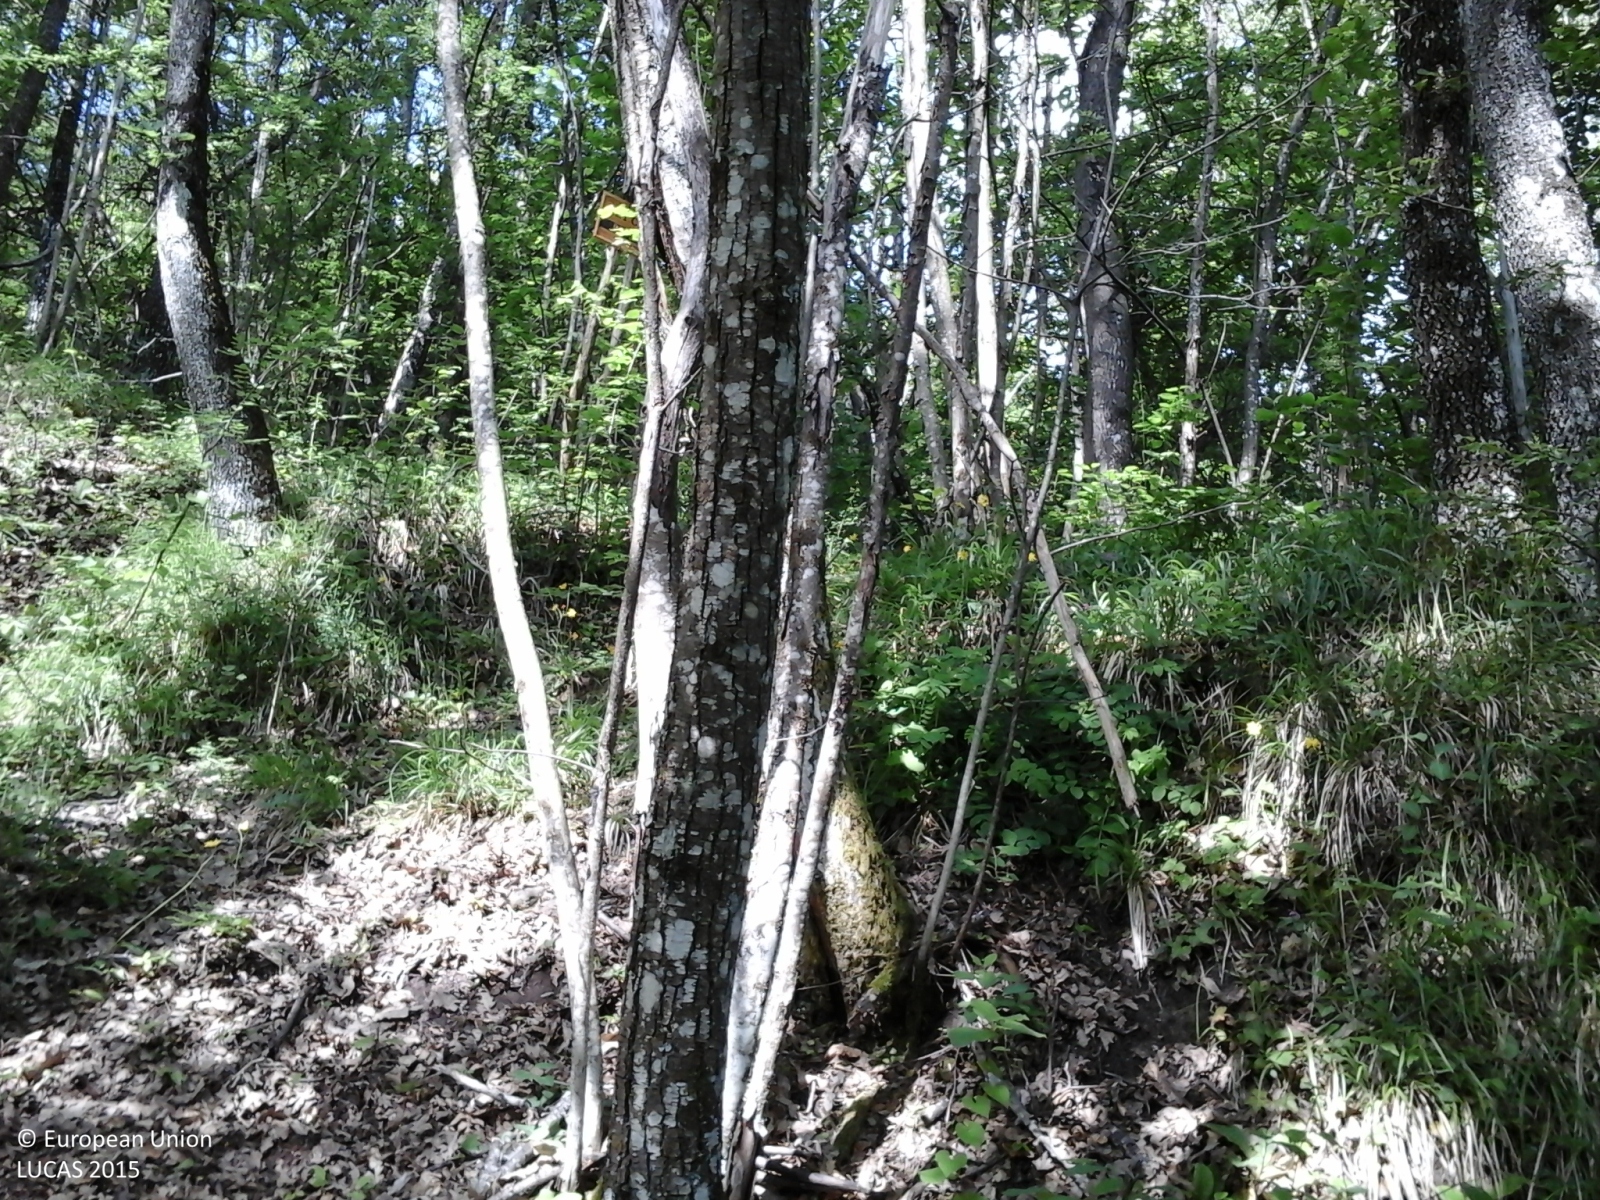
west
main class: Woodland
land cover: Broadleaved woodland
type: thermophilous deciduous forest
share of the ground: > 75 %
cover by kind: broadleaved forest trees 95 %, shrubs 5 %
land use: Forestry
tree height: > 5 m
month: May
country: IT
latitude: 44.5128
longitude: 10.1130
